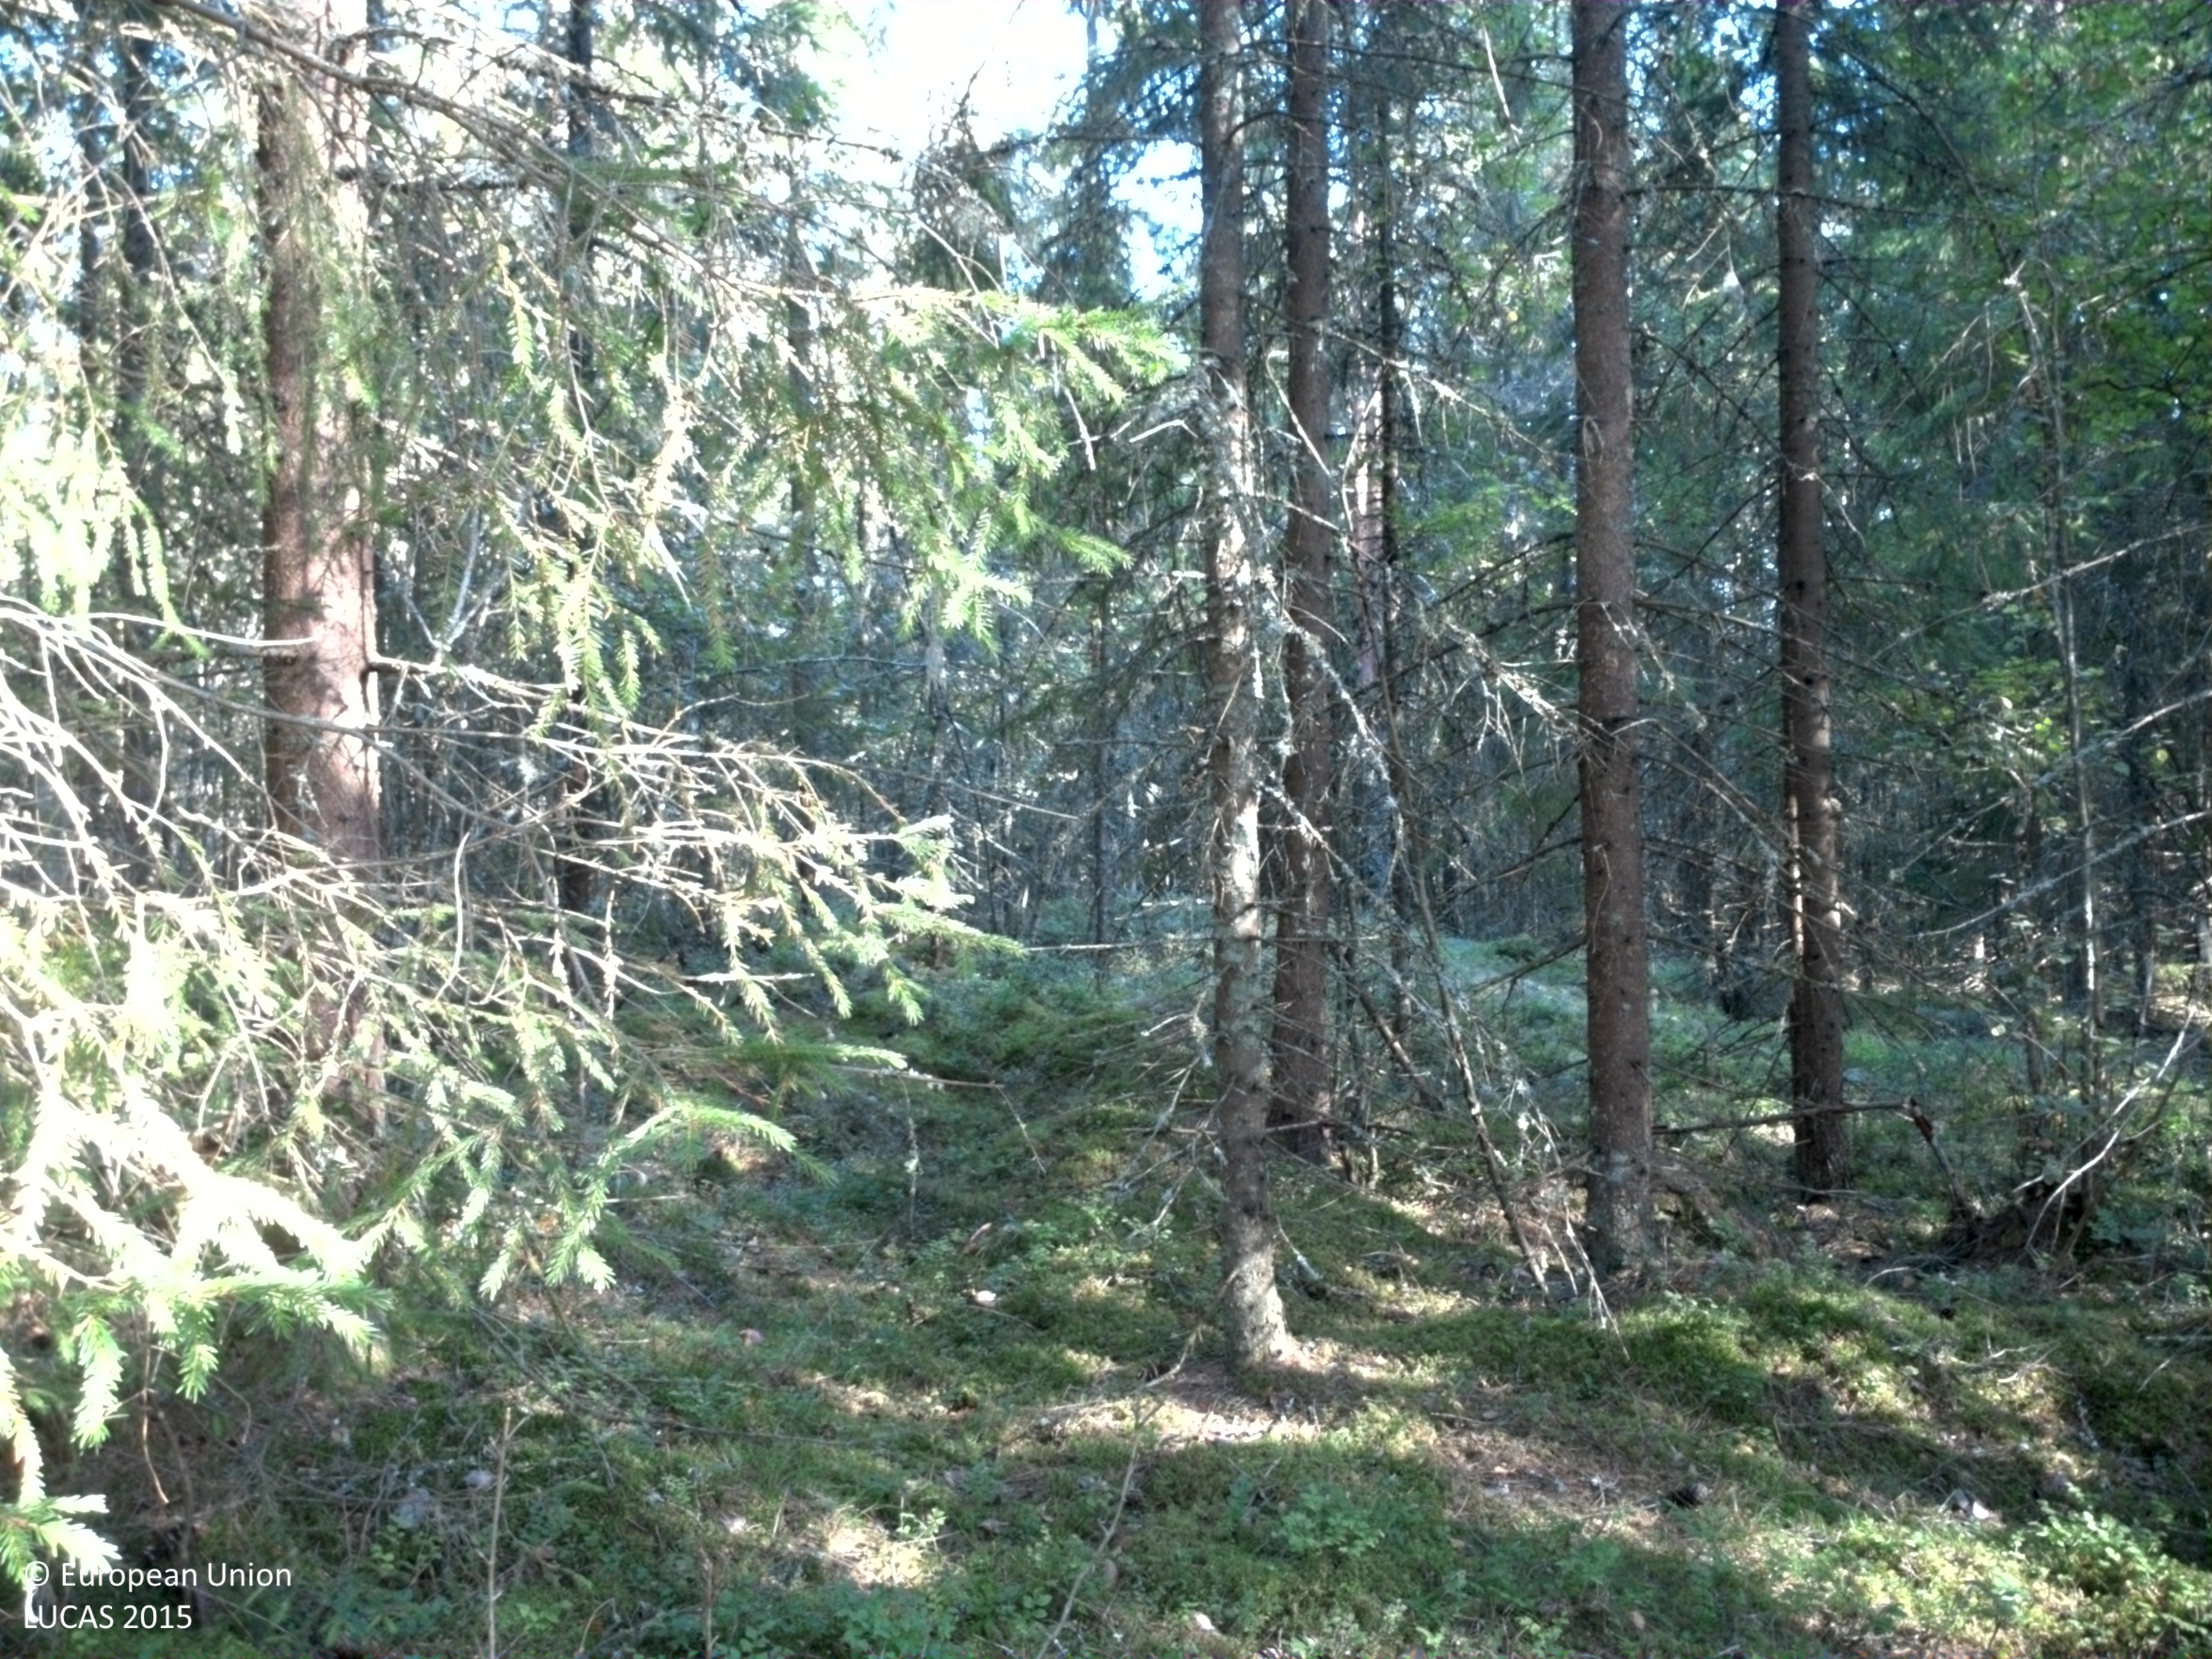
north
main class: Woodland
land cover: Spruce dominated coniferous woodland
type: boreal forest
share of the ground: 50 - 75 %
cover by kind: coniferous forest trees 60 %, lichens and mosses 20 %, shrubs 15 %, broadleaved forest trees 5 %
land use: Forestry
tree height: > 5 m
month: August
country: SE
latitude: 59.5099
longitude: 13.3669
